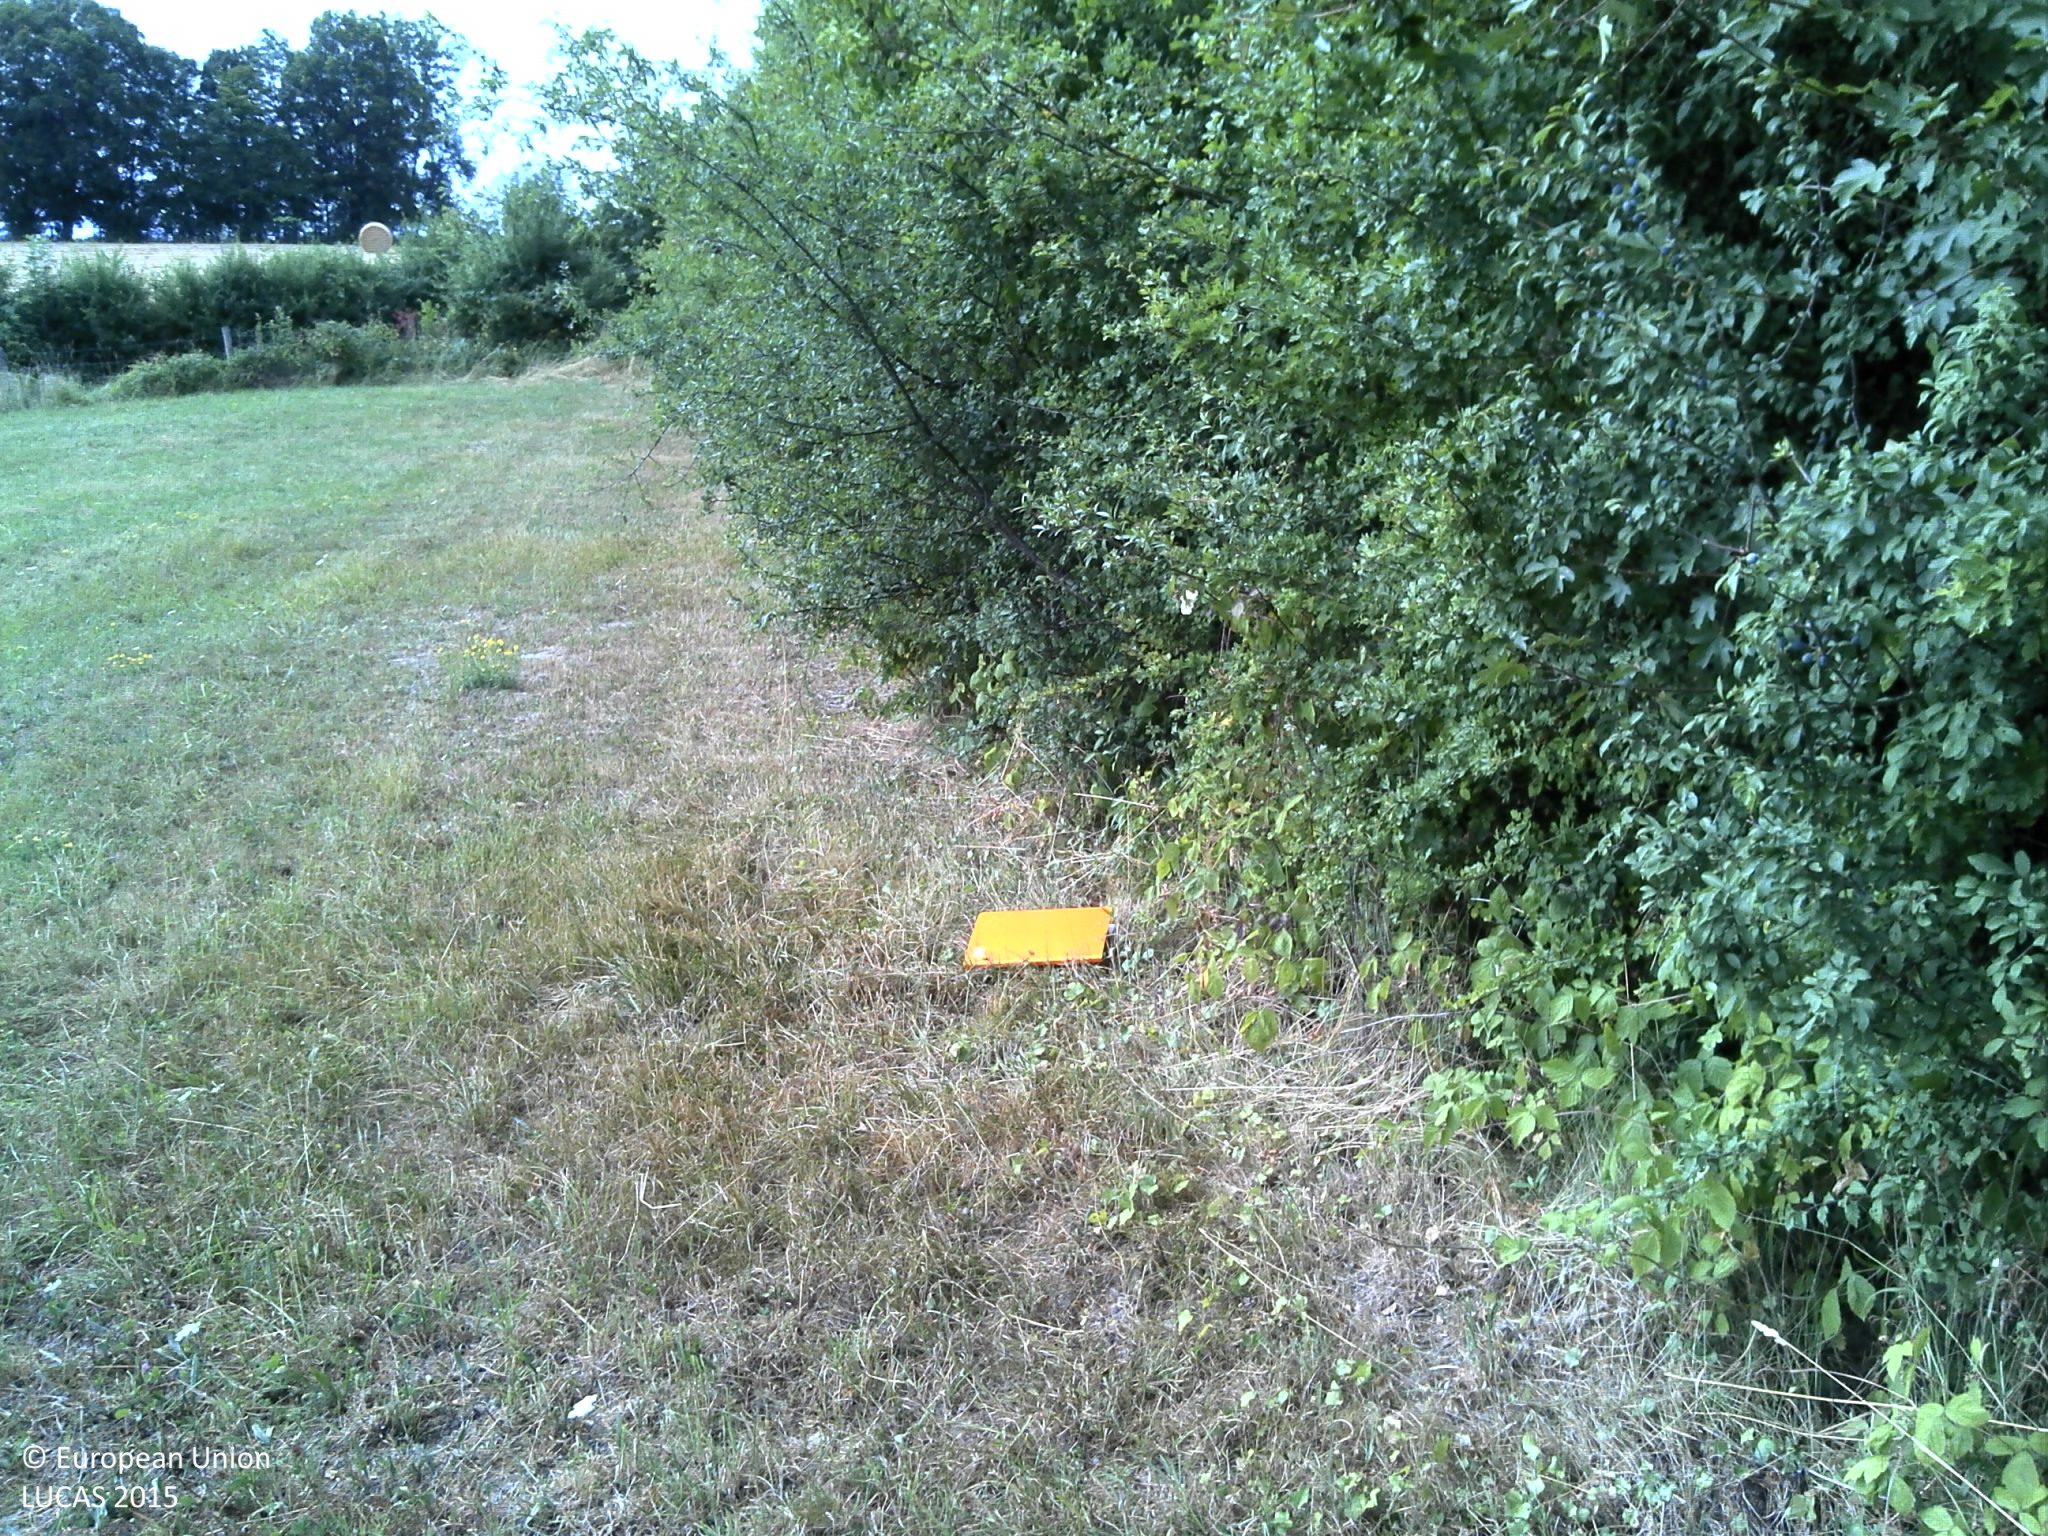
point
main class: Grassland
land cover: Grassland without tree/shrub cover
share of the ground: > 75 %
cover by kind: herbaceous plants 100 %
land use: Agriculture (excluding fallow land and kitchen gardens)
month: July
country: FR
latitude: 48.1192
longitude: 6.1183
